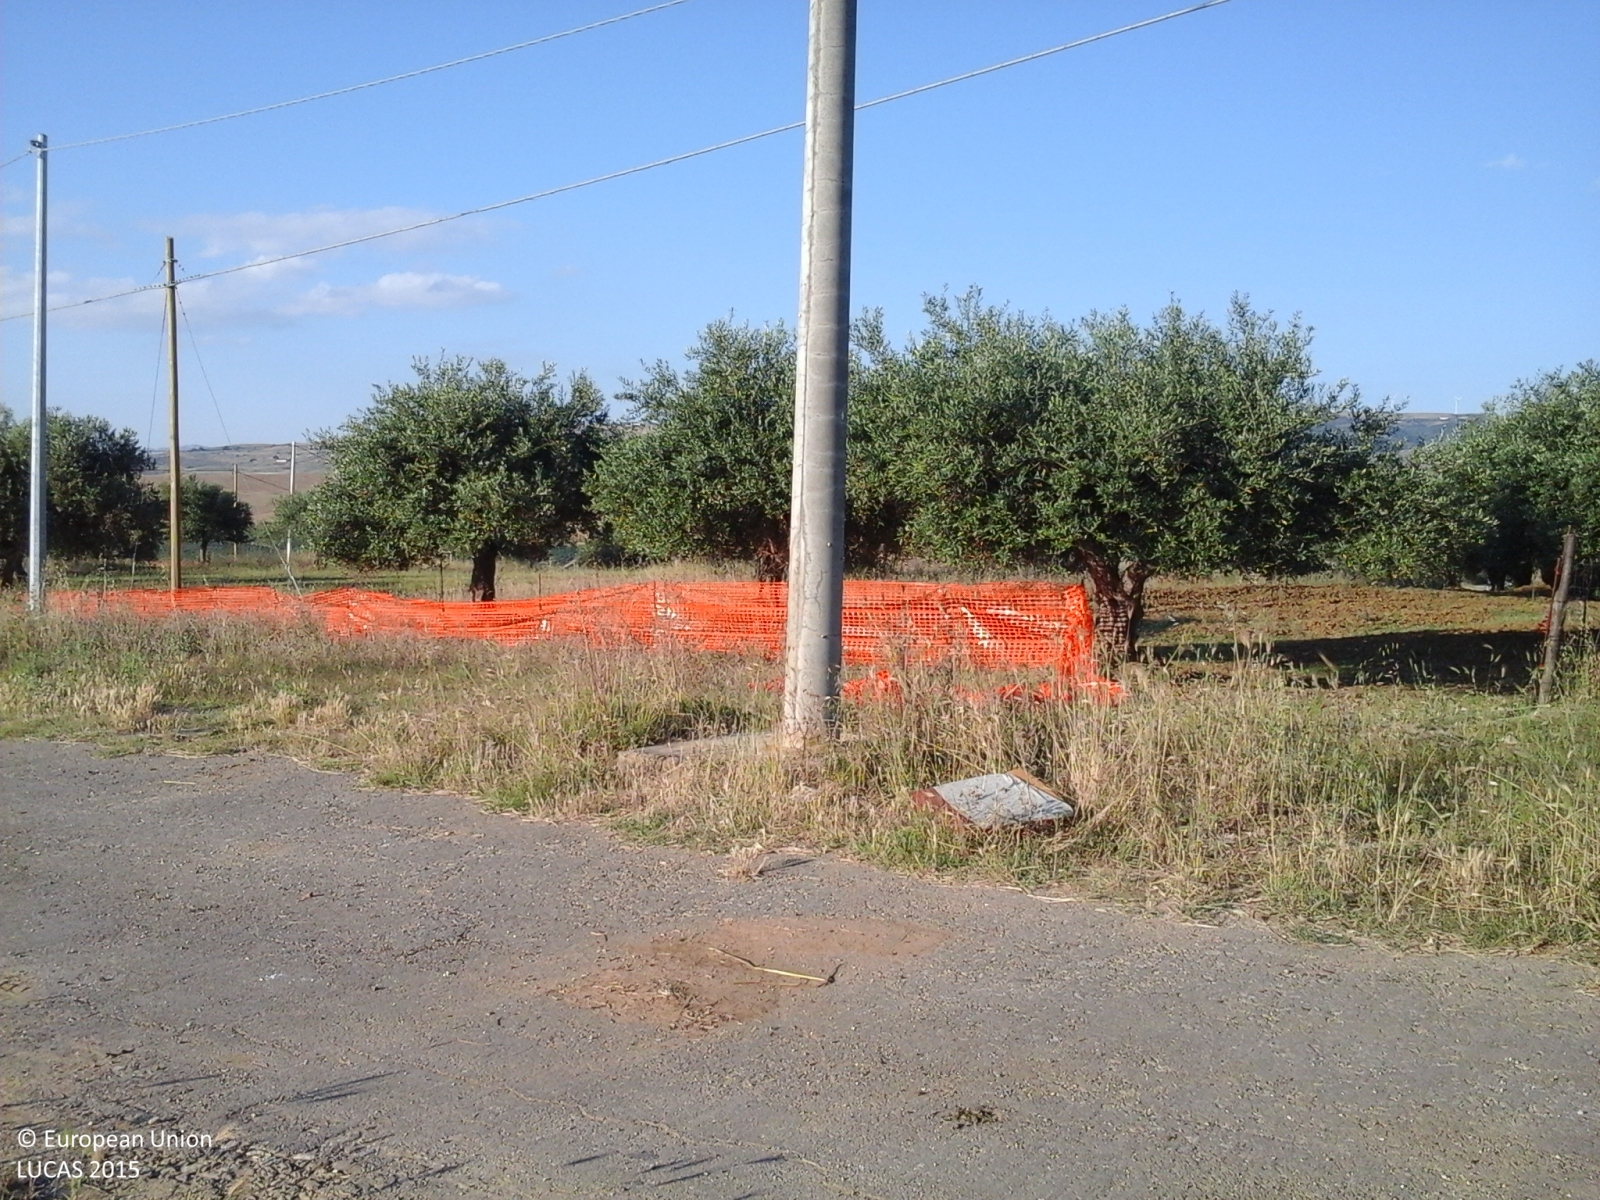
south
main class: Grassland
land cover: Spontaneously vegetated surfaces
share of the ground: > 75 %
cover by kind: herbaceous plants 100 %
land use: Fallow land
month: June
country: IT
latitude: 37.8644
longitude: 13.5098
